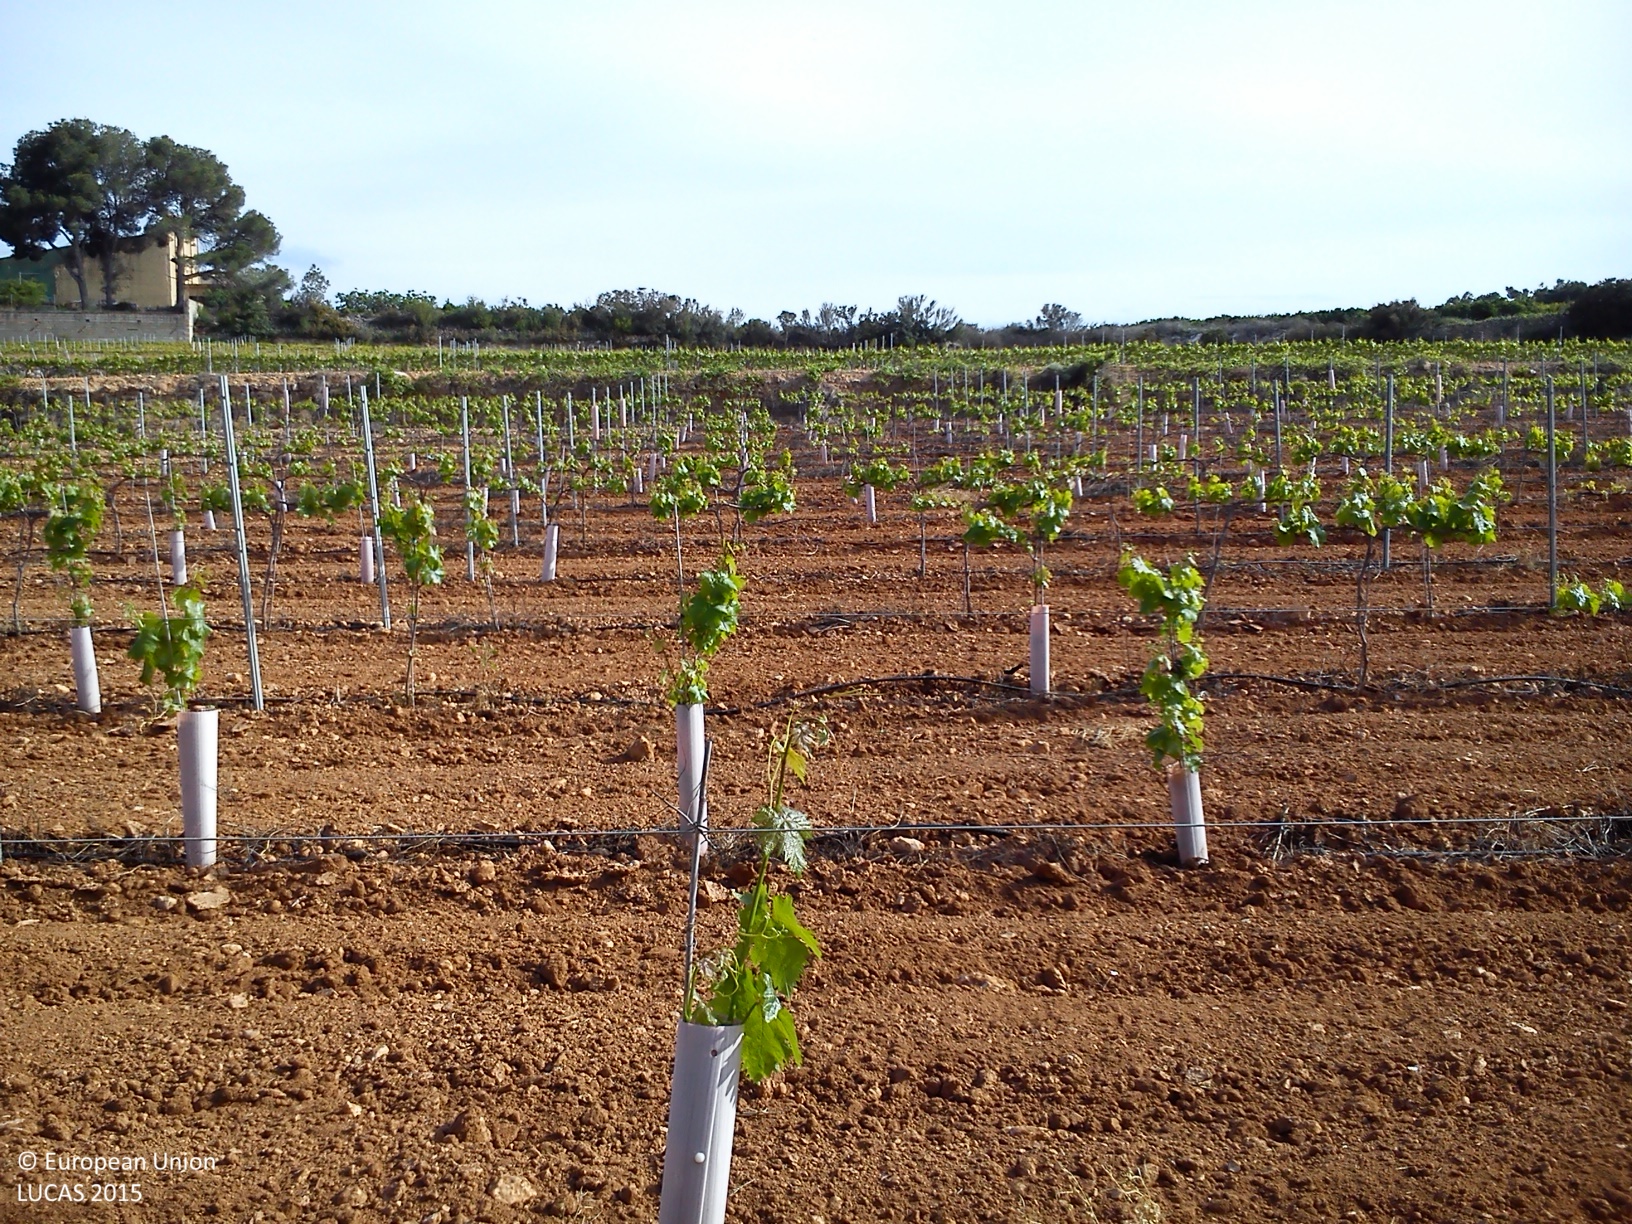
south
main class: Cropland
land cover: Vineyards
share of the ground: 10 - 25 %
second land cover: Other bare soil
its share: > 75 %
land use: Agriculture (excluding fallow land and kitchen gardens)
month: April
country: ES
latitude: 39.4330
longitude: -0.6283
